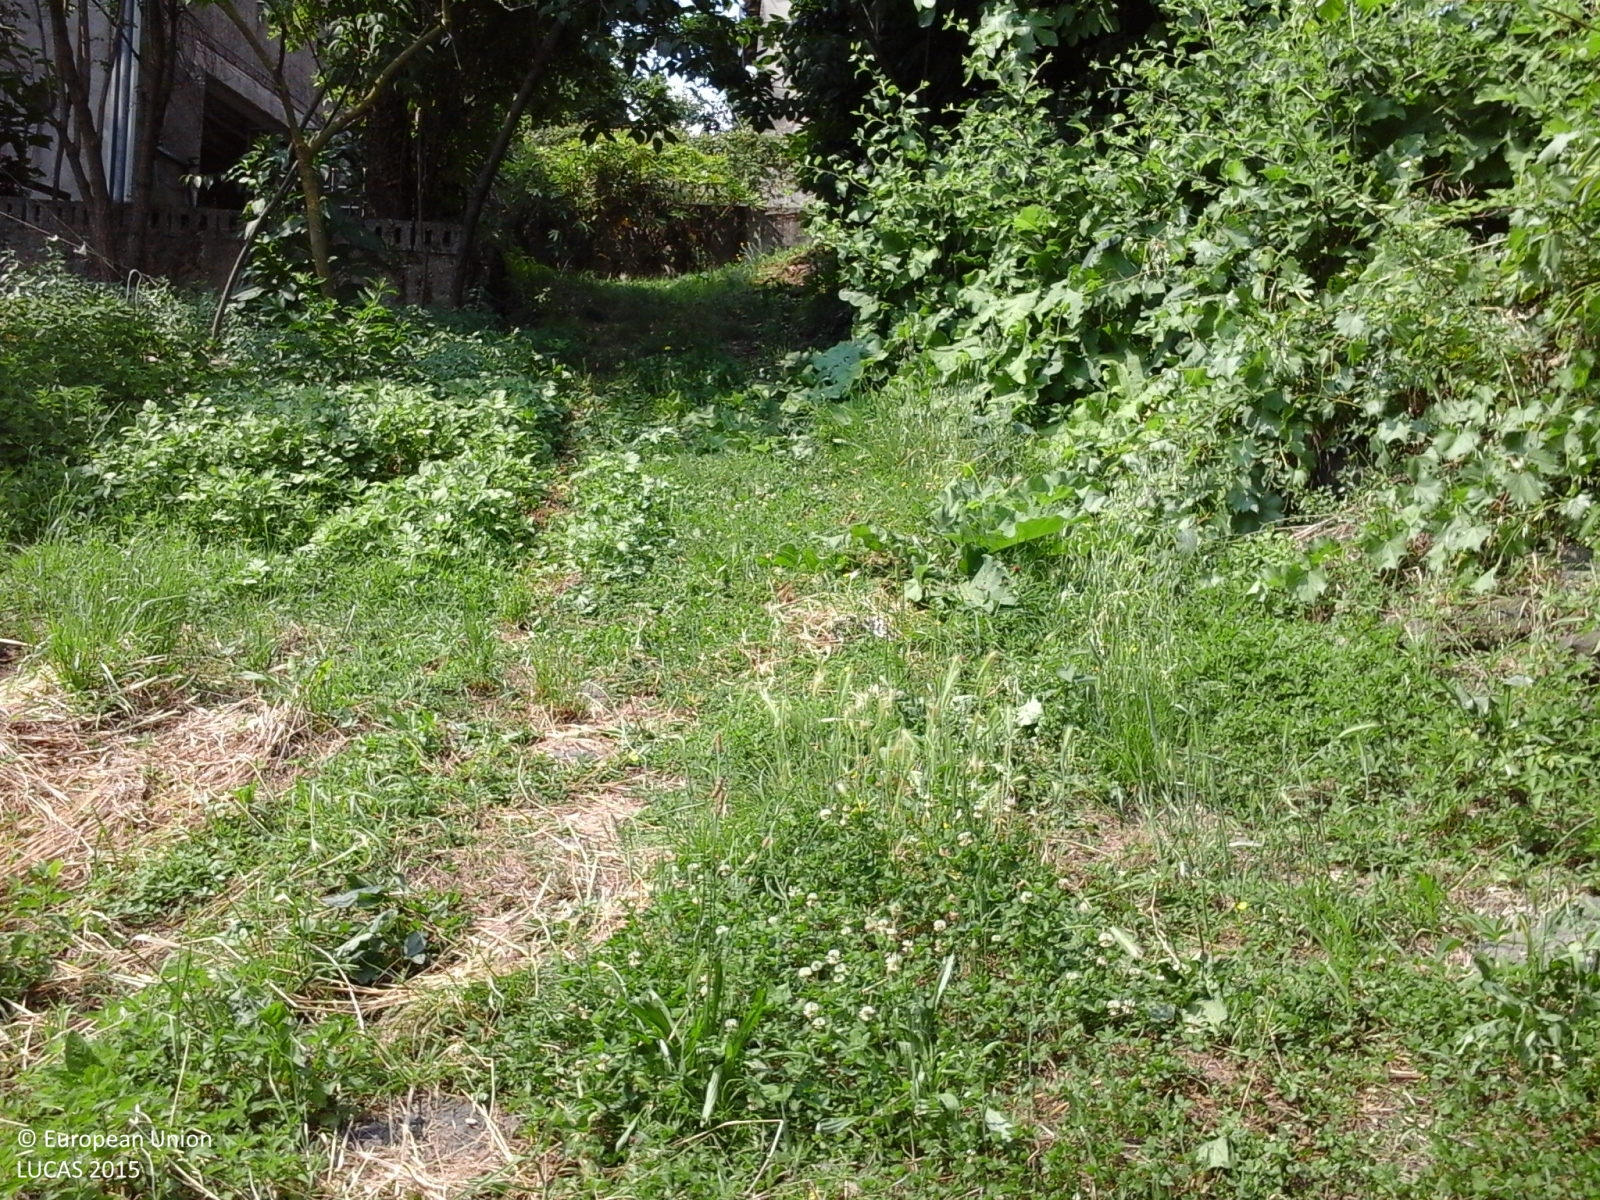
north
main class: Woodland
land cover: Broadleaved woodland
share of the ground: > 75 %
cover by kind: broadleaved forest trees 100 %
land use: Agriculture (excluding fallow land and kitchen gardens)
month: June
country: IT
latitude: 45.7445
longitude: 11.6042
